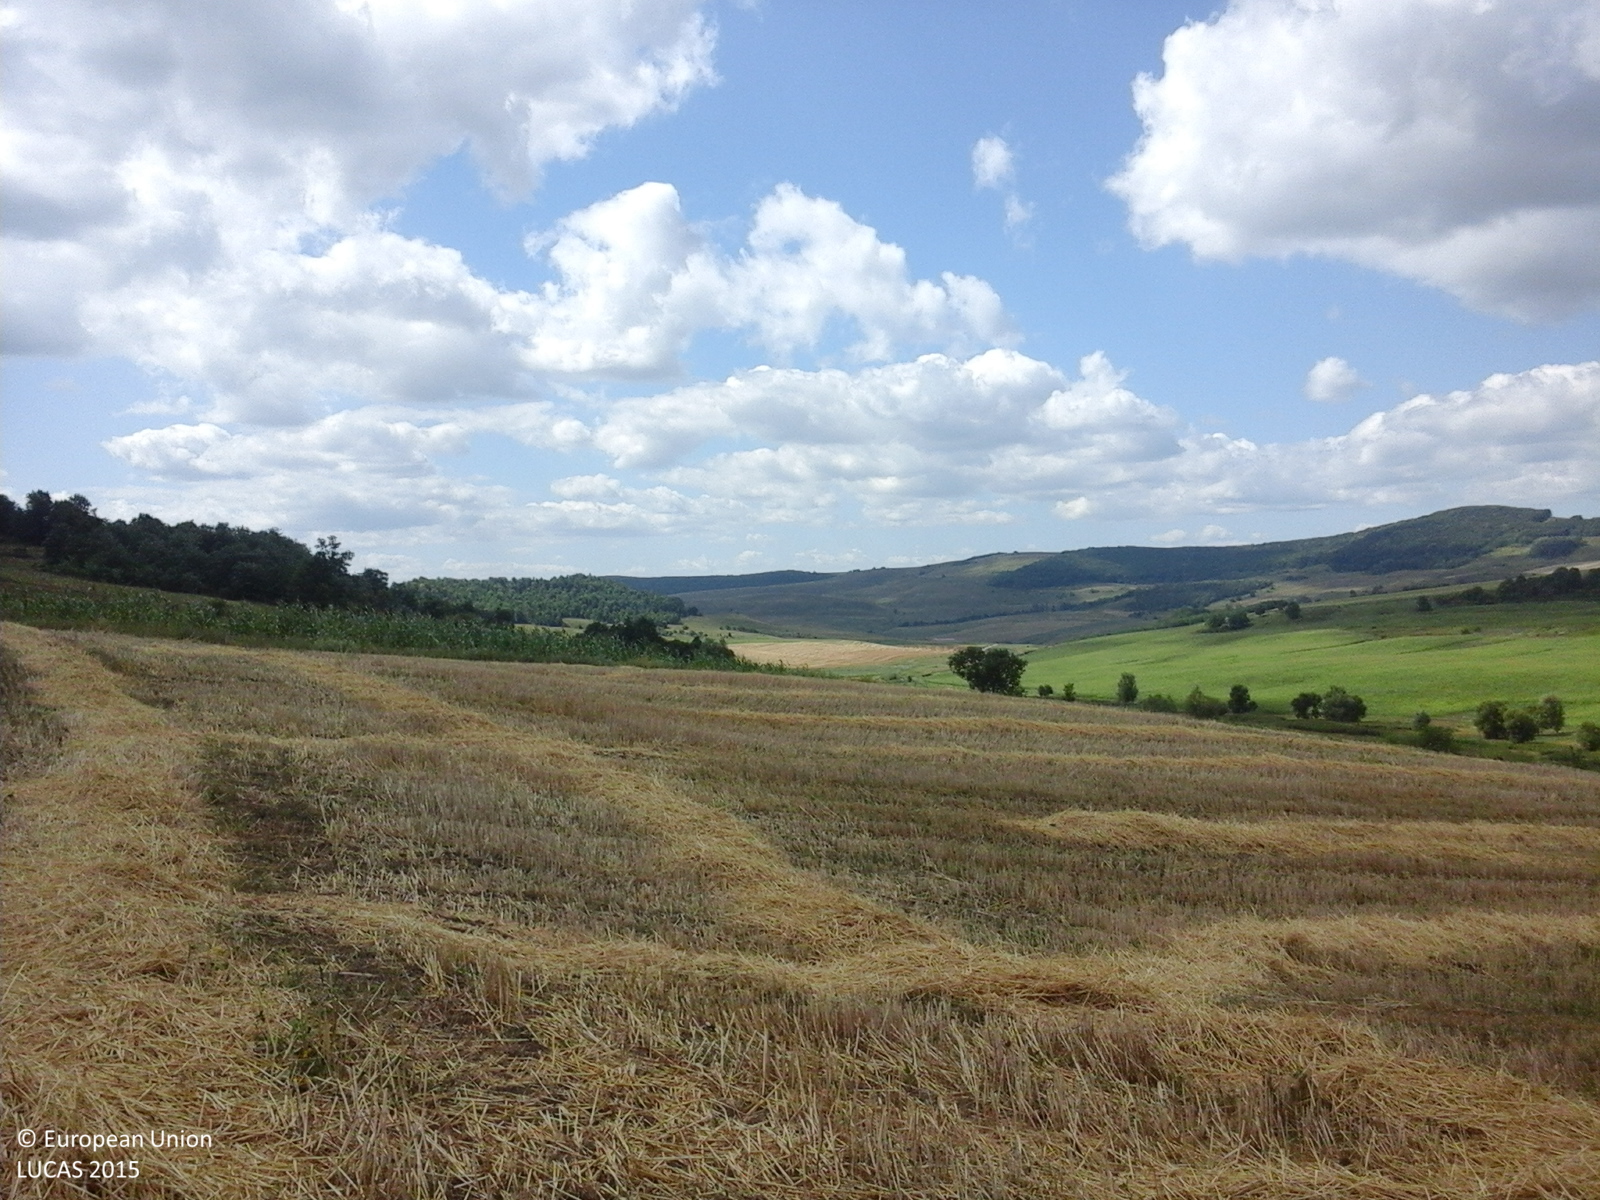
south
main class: Cropland
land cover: Triticale
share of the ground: 50 - 75 %
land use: Agriculture (excluding fallow land and kitchen gardens)
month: July
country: RO
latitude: 46.6152
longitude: 27.2221
